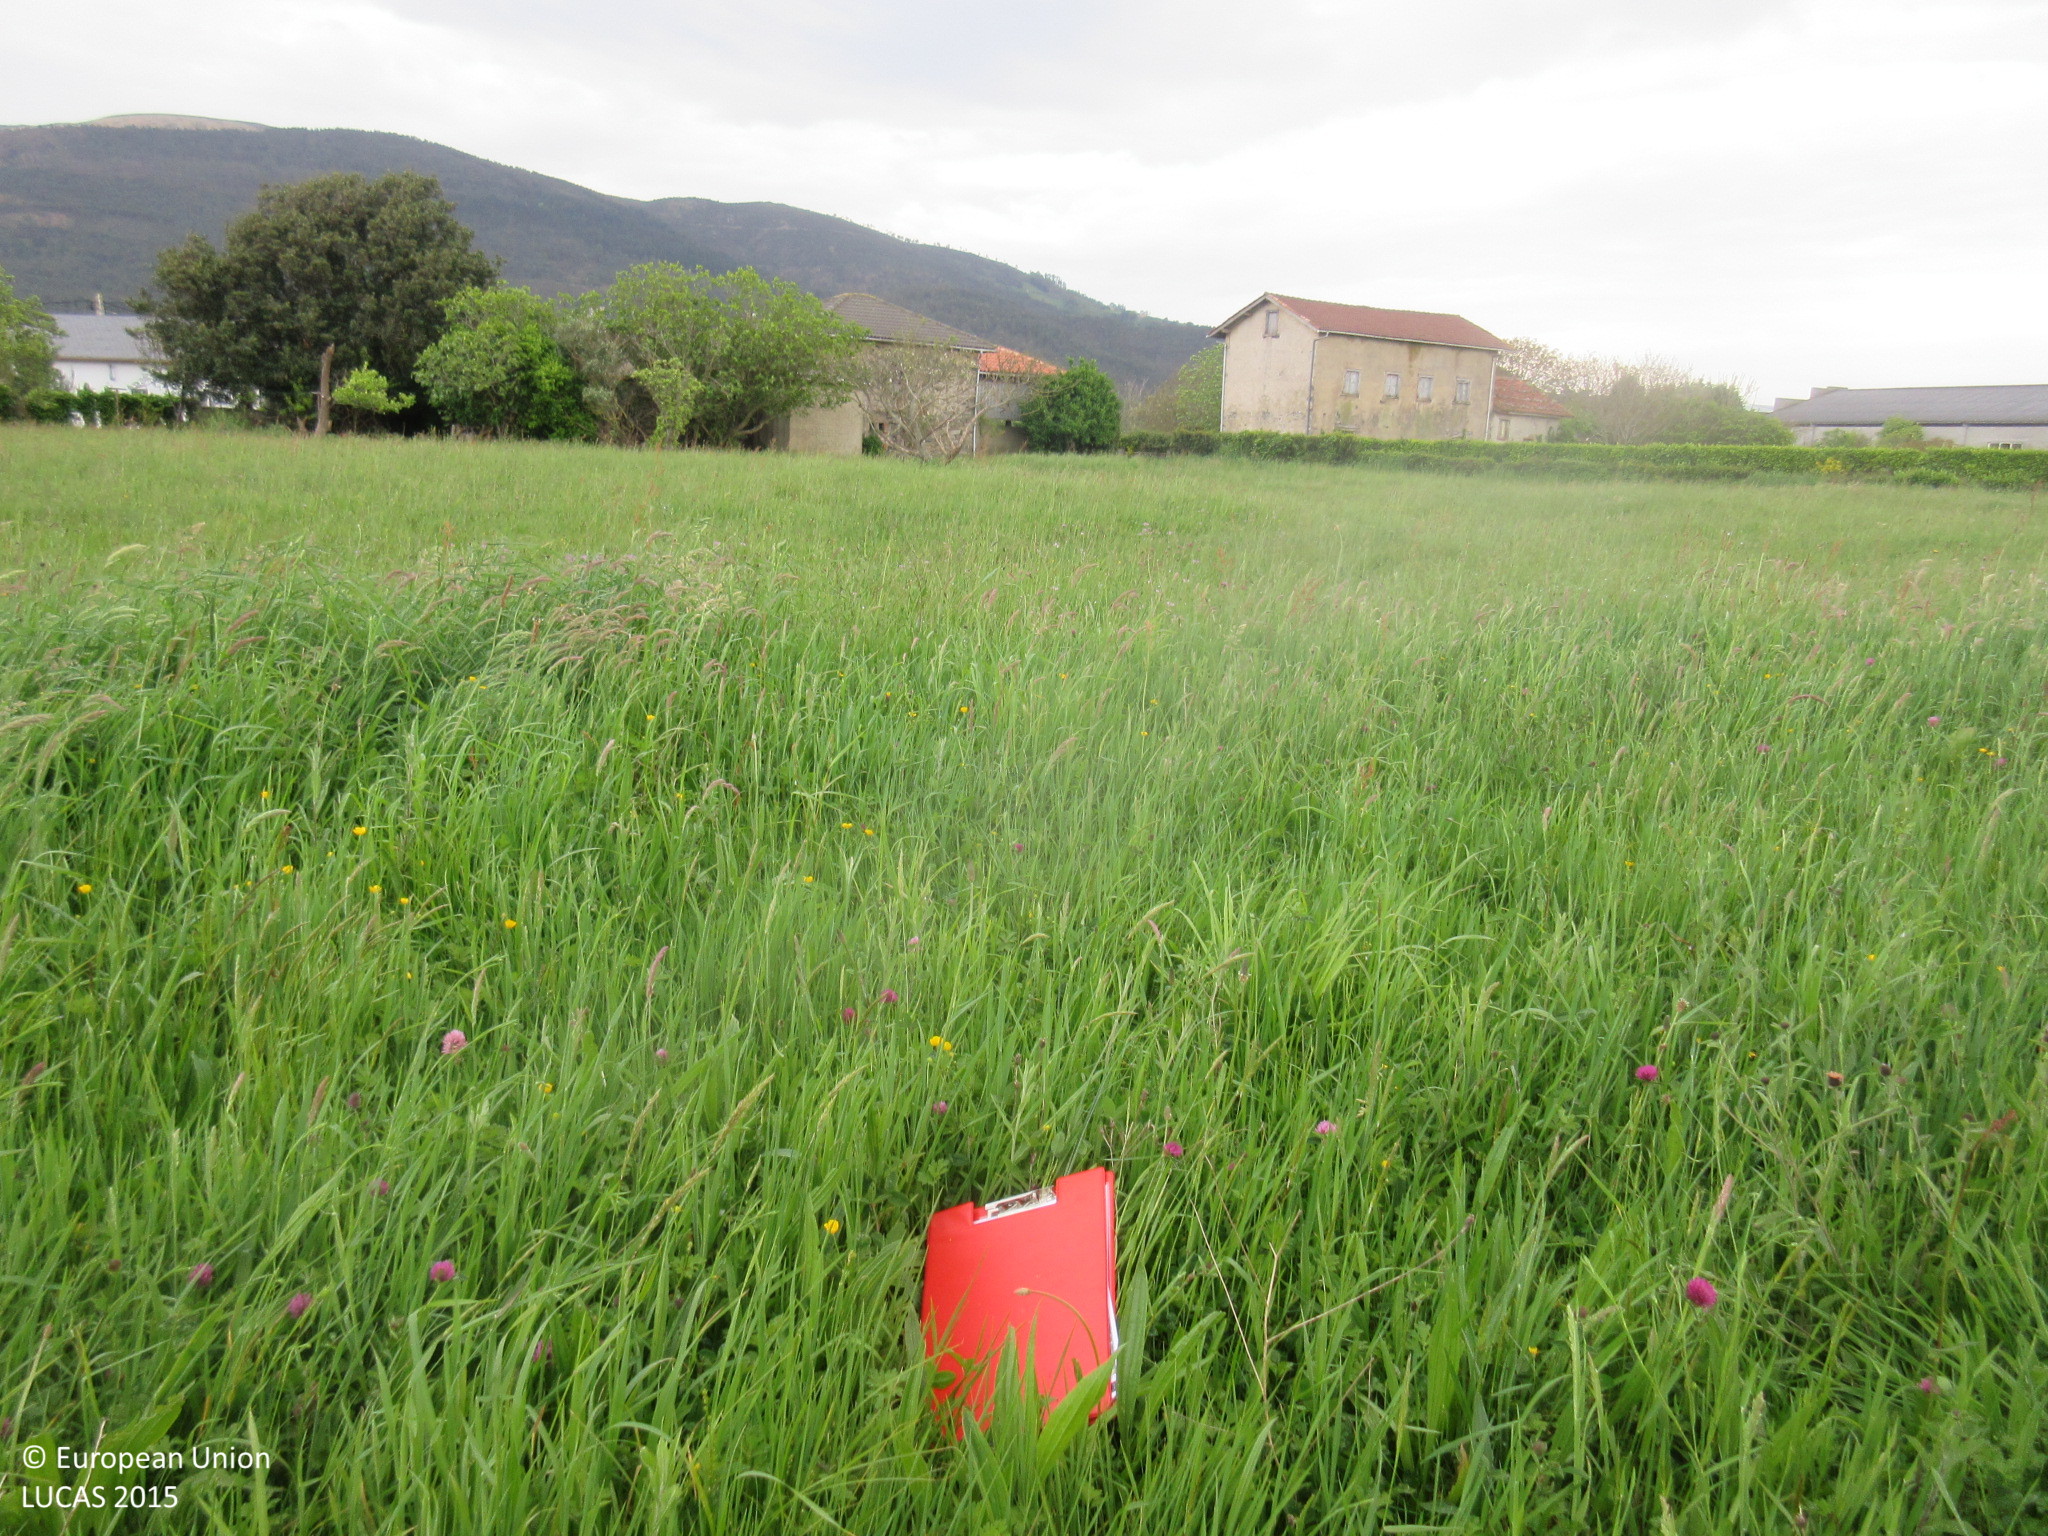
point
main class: Grassland
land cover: Grassland without tree/shrub cover
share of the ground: > 75 %
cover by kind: herbaceous plants 100 %
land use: Agriculture (excluding fallow land and kitchen gardens)
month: April
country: ES
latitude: 43.5528
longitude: -6.3797
